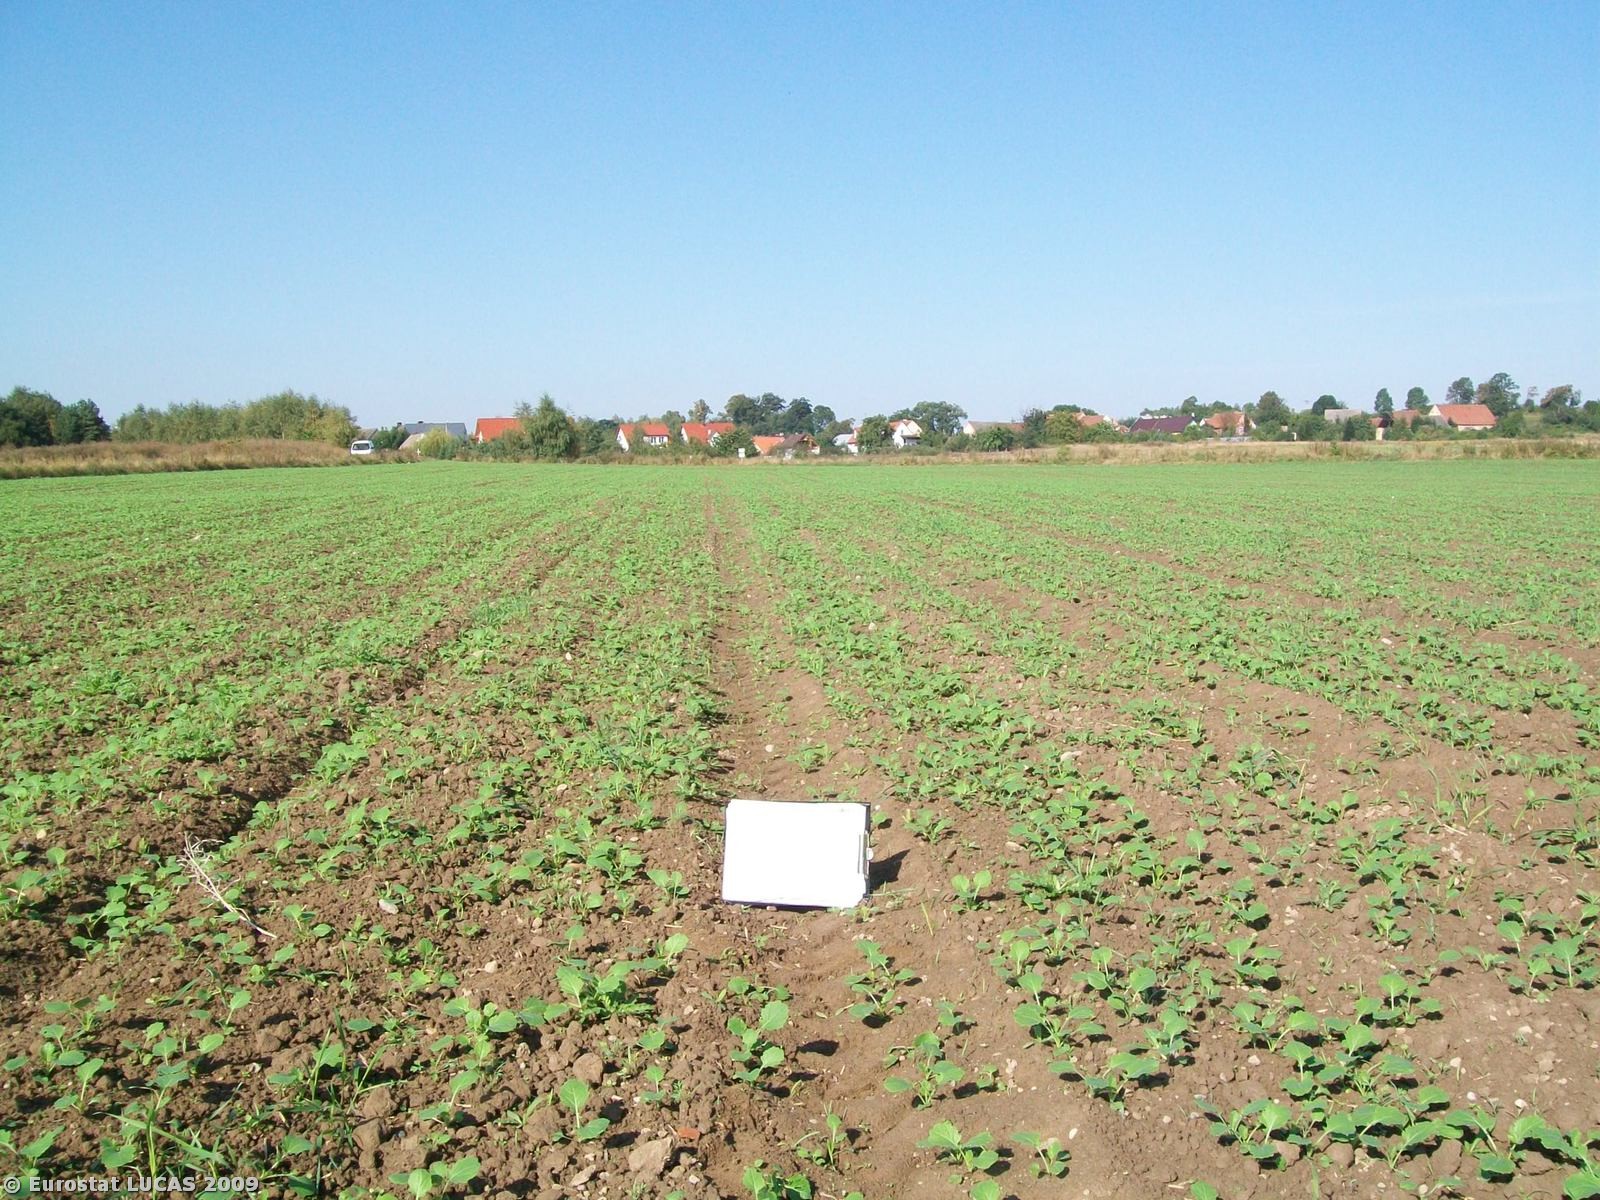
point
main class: Cropland
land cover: Common wheat
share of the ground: < 10 %
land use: Agriculture (excluding fallow land and kitchen gardens)
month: September
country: PL
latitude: 50.4775
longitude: 17.2402
